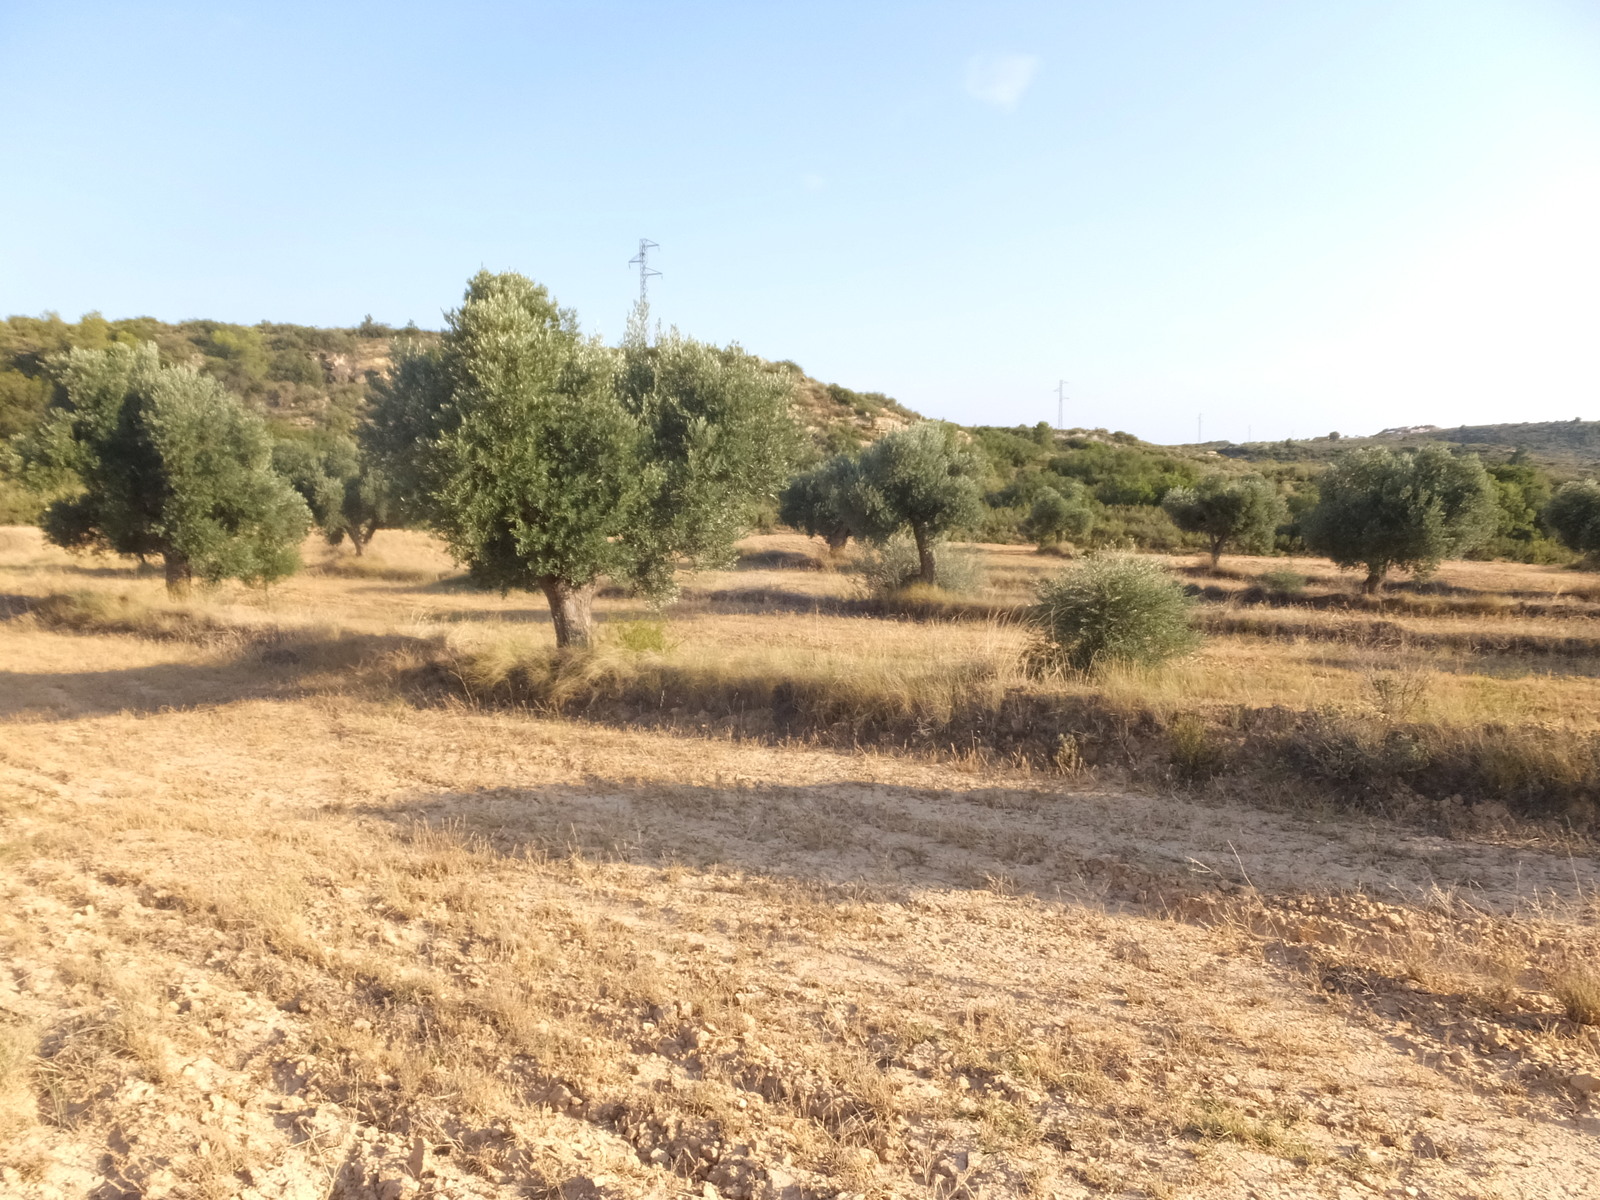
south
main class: Shrubland
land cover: Shrubland without tree cover
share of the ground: > 75 %
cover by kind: consolidated bare surface 60 %, shrubs 20 %, herbaceous plants 20 %
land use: Semi-natural and natural areas not in use
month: July
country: ES
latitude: 41.1550
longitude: 0.1582
